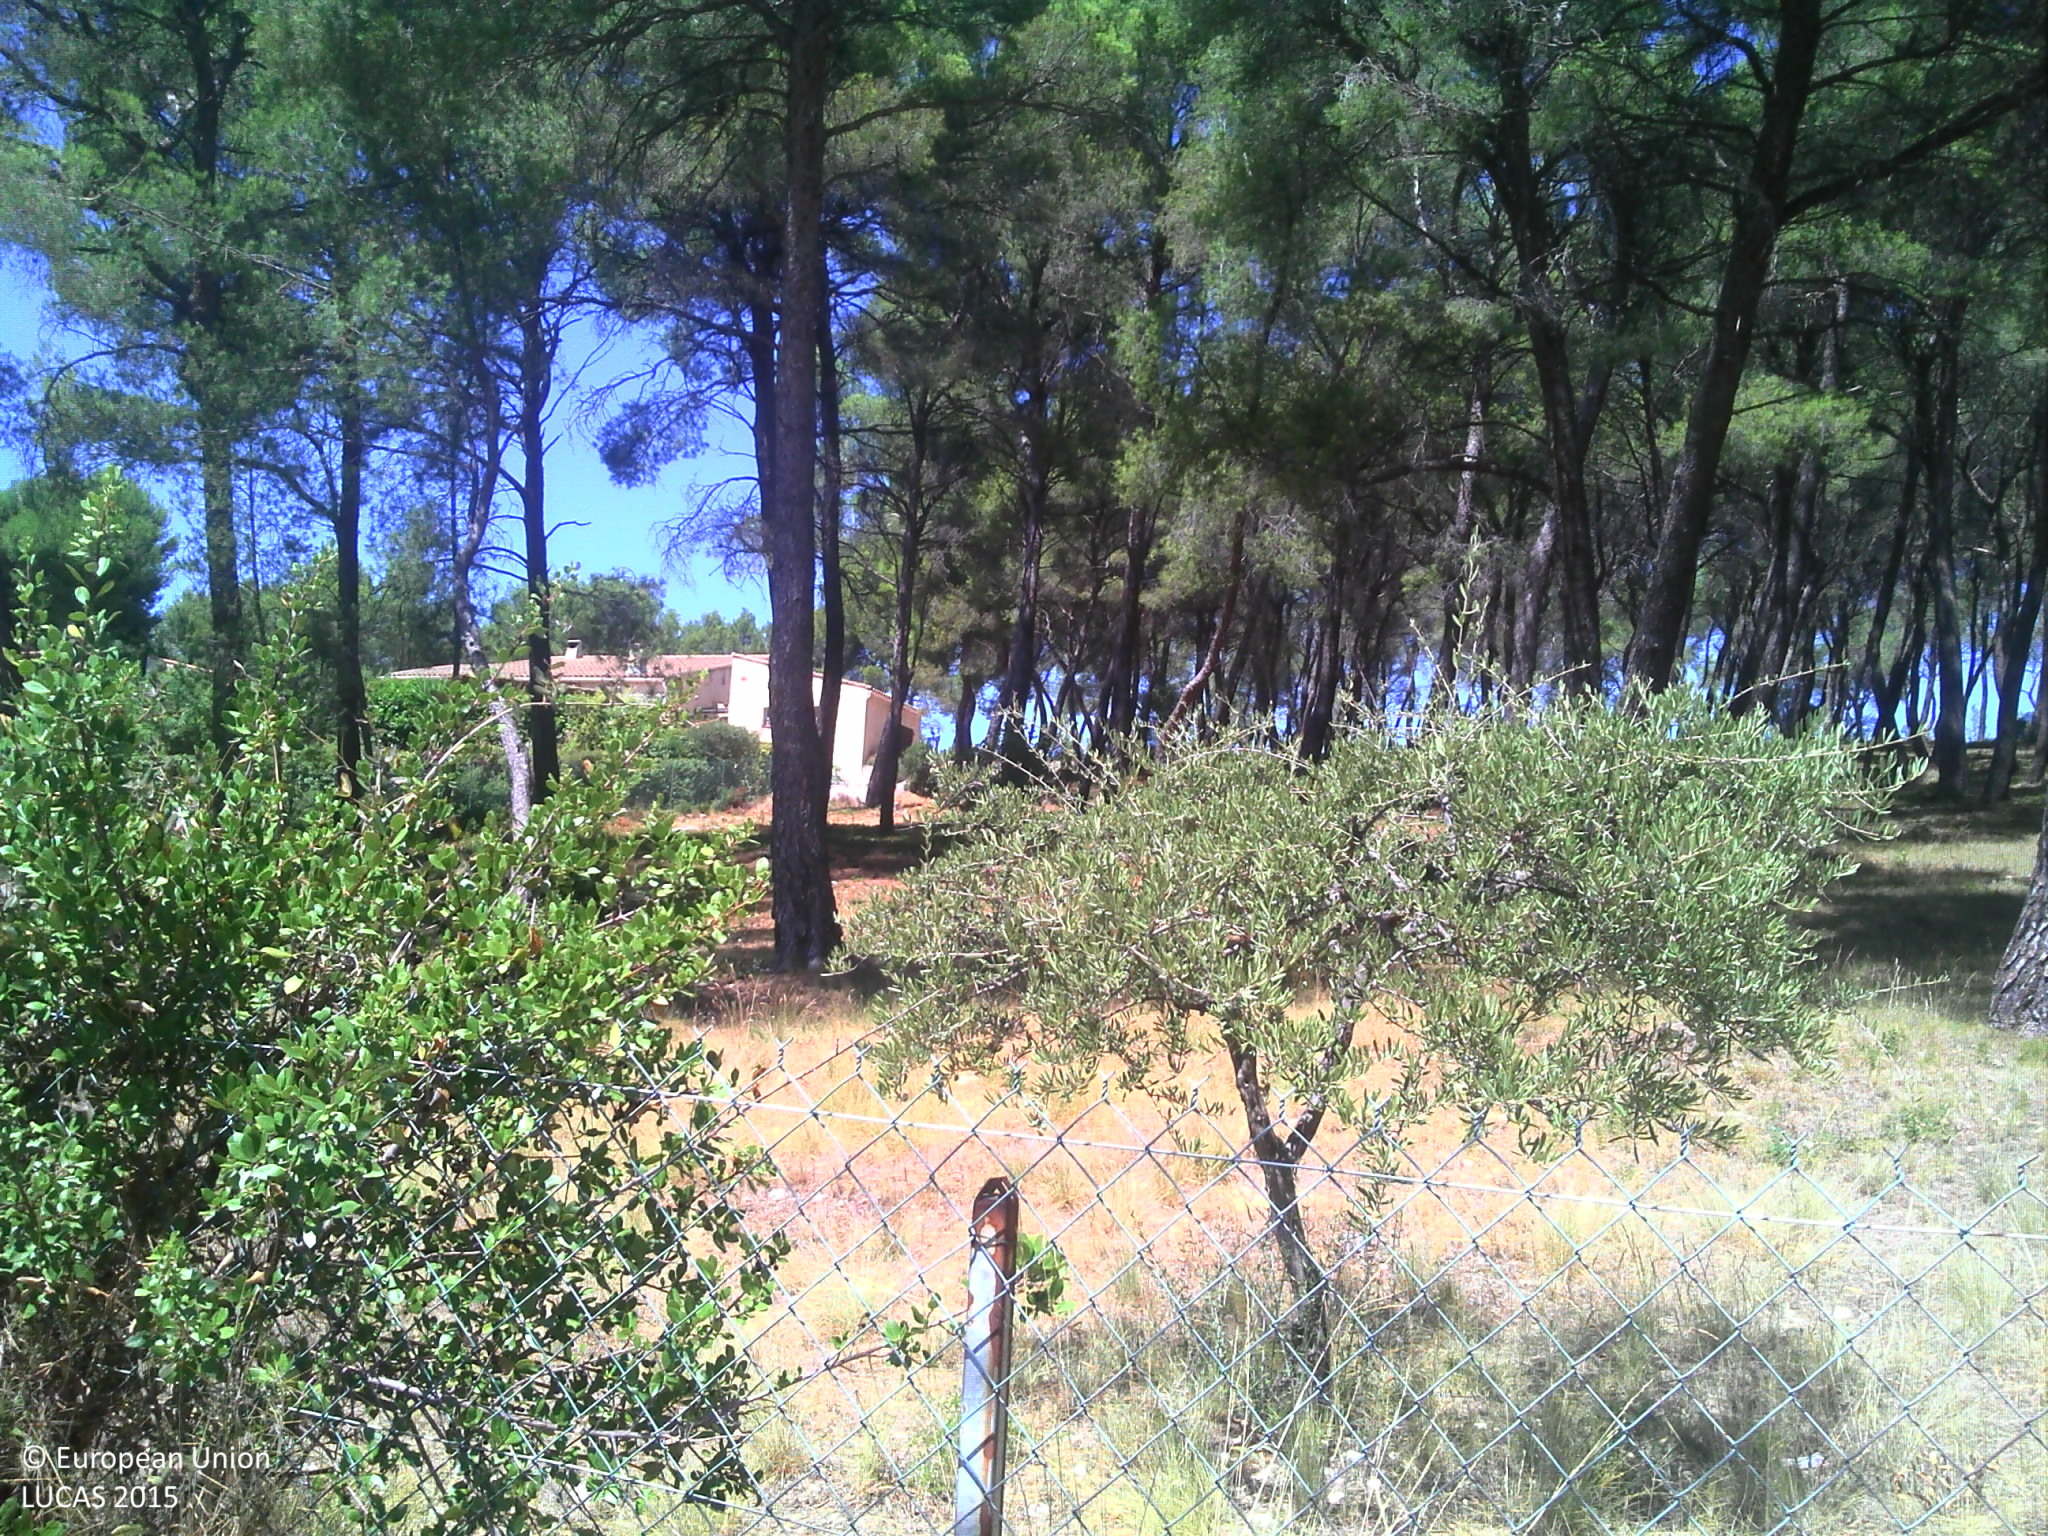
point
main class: Woodland
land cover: Pine dominated coniferous woodland
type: coniferous forest of the mediterranean region
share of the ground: > 75 %
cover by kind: coniferous forest trees 80 %, herbaceous plants 15 %, consolidated bare surface 5 %
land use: Forestry
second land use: Residential
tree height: > 5 m
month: August
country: FR
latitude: 43.2259
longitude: 5.5658
